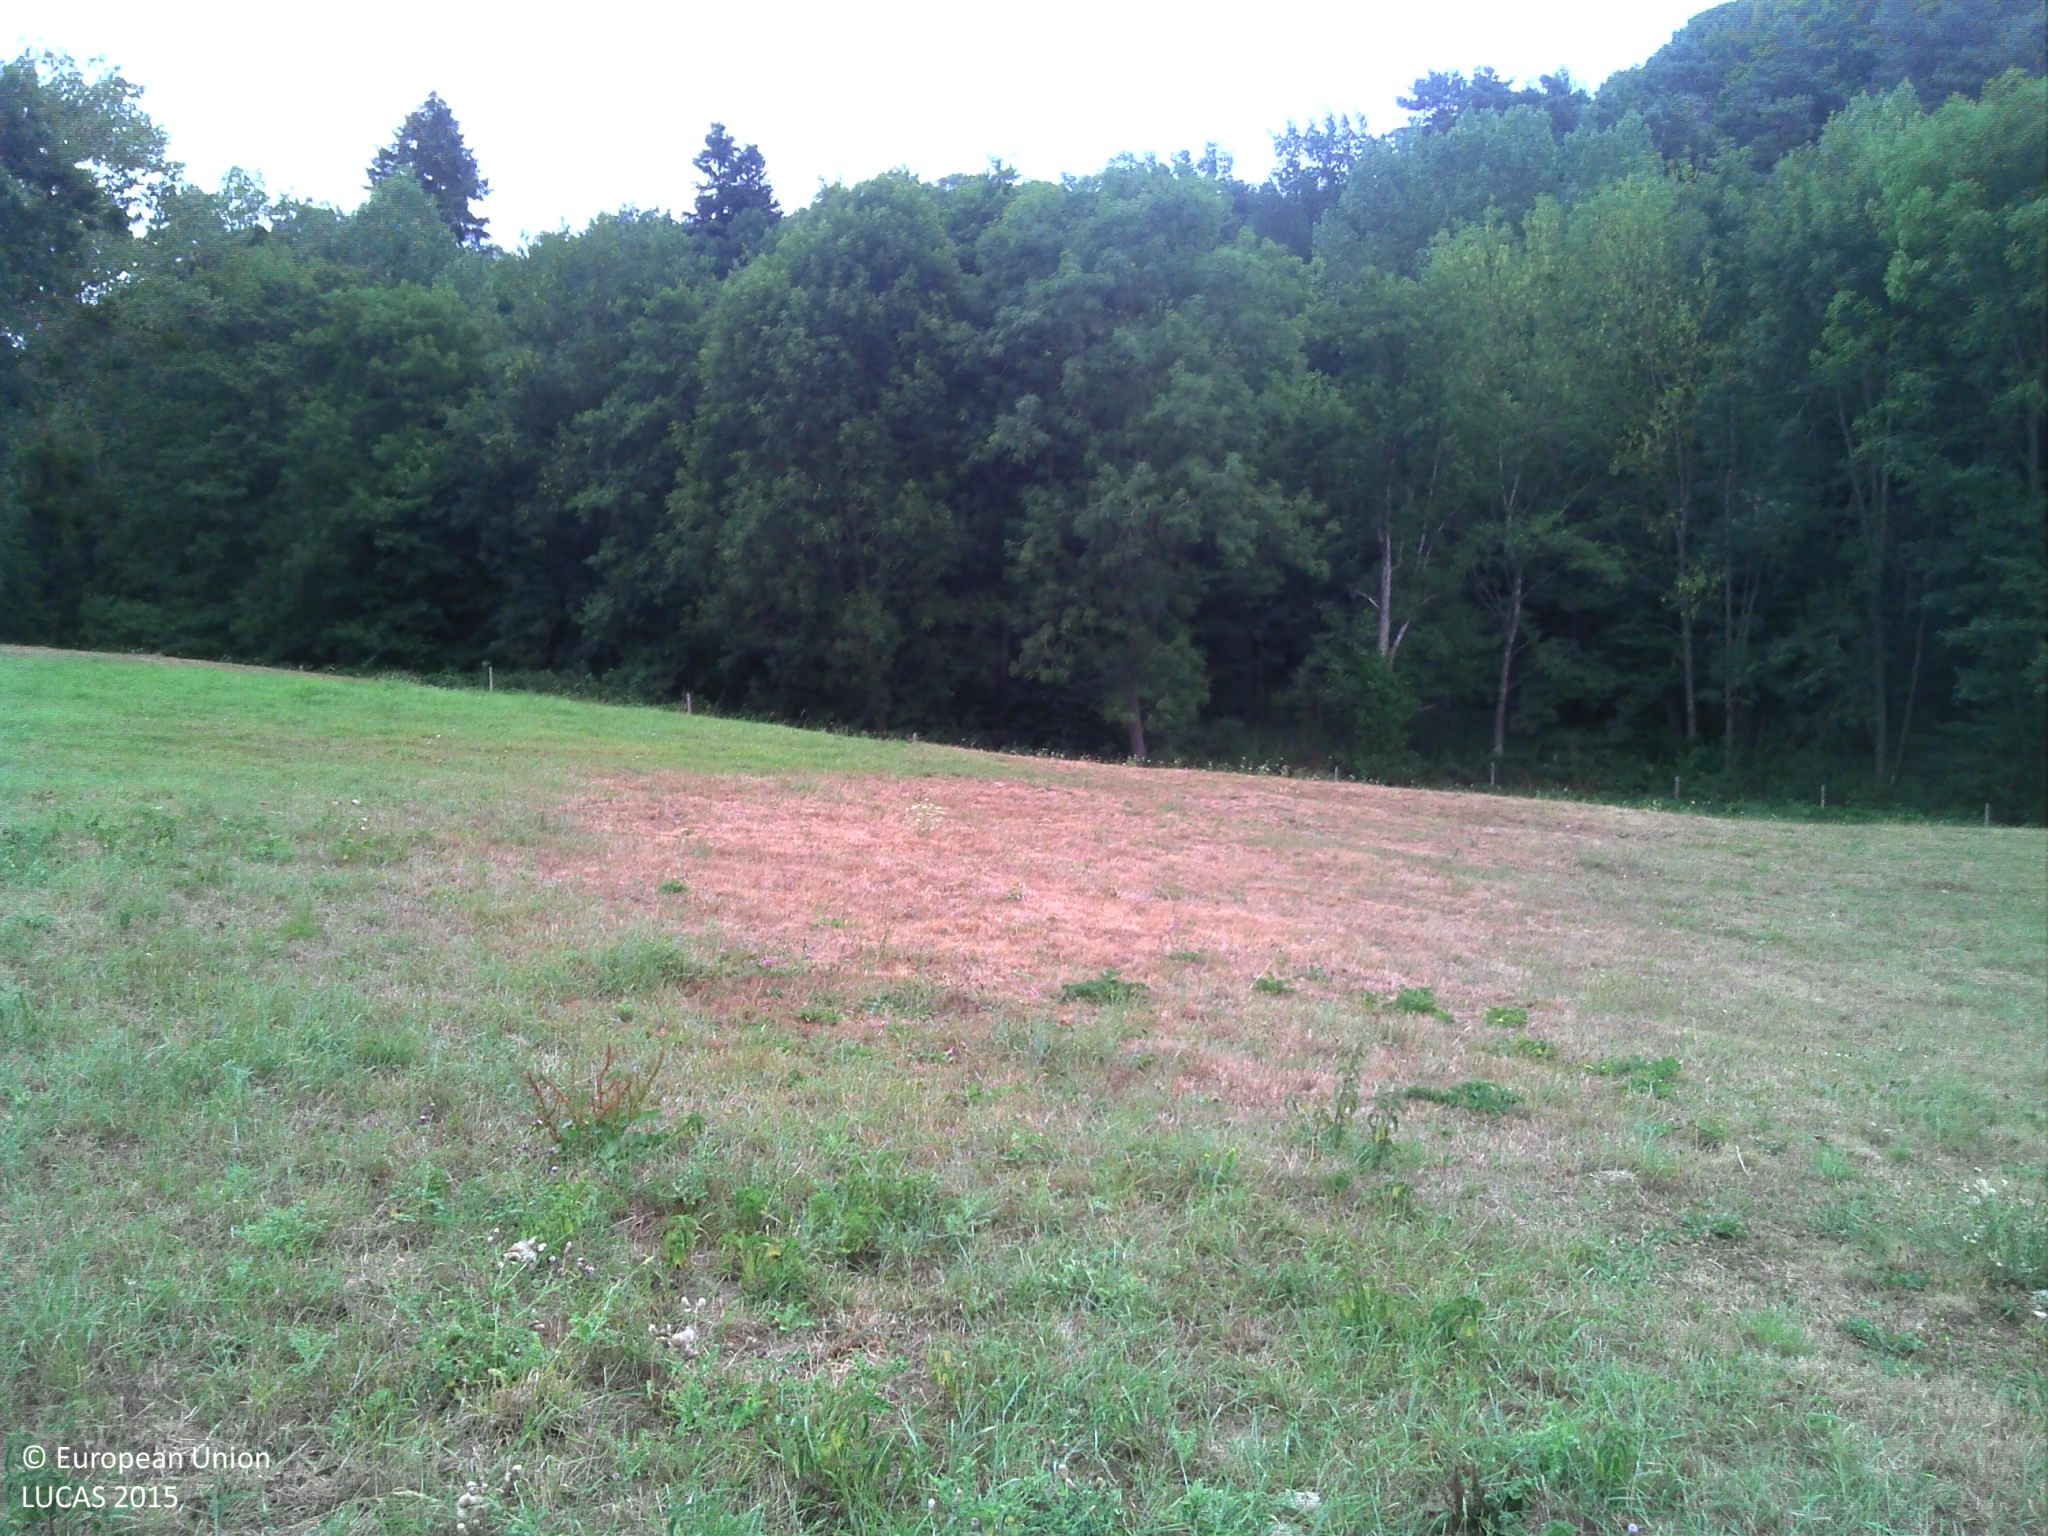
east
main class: Grassland
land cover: Grassland without tree/shrub cover
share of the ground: > 75 %
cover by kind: herbaceous plants 100 %
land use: Agriculture (excluding fallow land and kitchen gardens)
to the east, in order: Grassland without tree/shrub cover; Fences; Broadleaved woodland; Rivers and streams; Broadleaved woodland
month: July
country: FR
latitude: 45.6486
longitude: 4.4730
